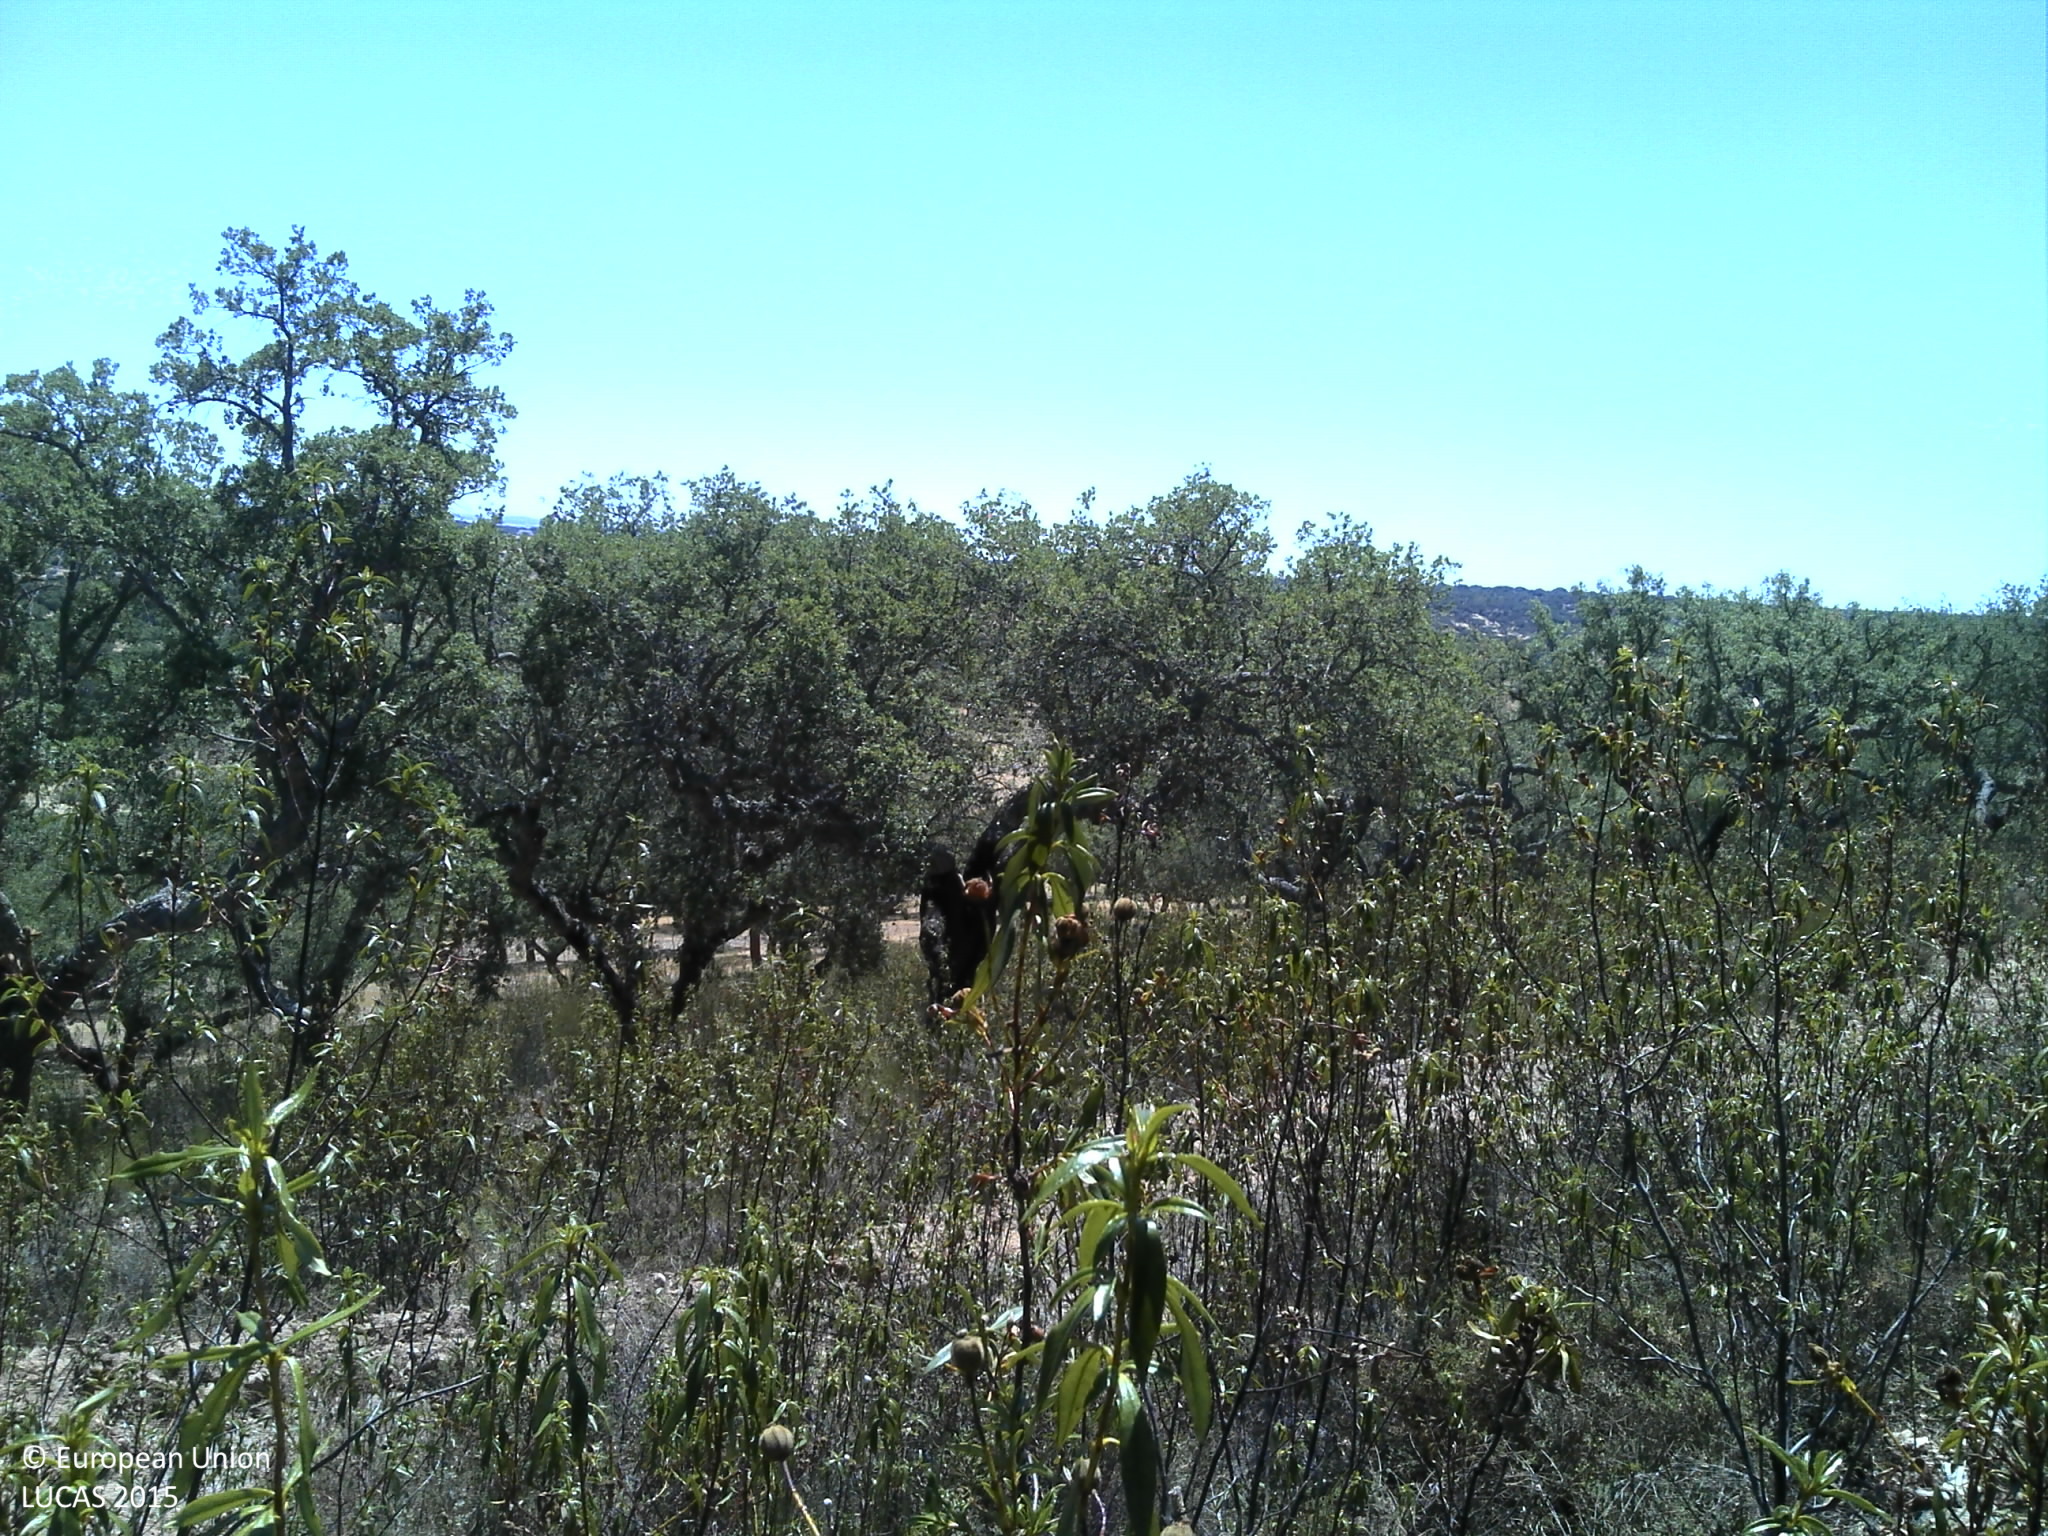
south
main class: Woodland
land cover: Broadleaved woodland
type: broadleaved evergreen forest
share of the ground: 25 - 50 %
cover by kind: shrubs 75 %, broadleaved forest trees 25 %
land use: Forestry
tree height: > 5 m
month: July
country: PT
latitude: 39.1469
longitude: -7.1690
